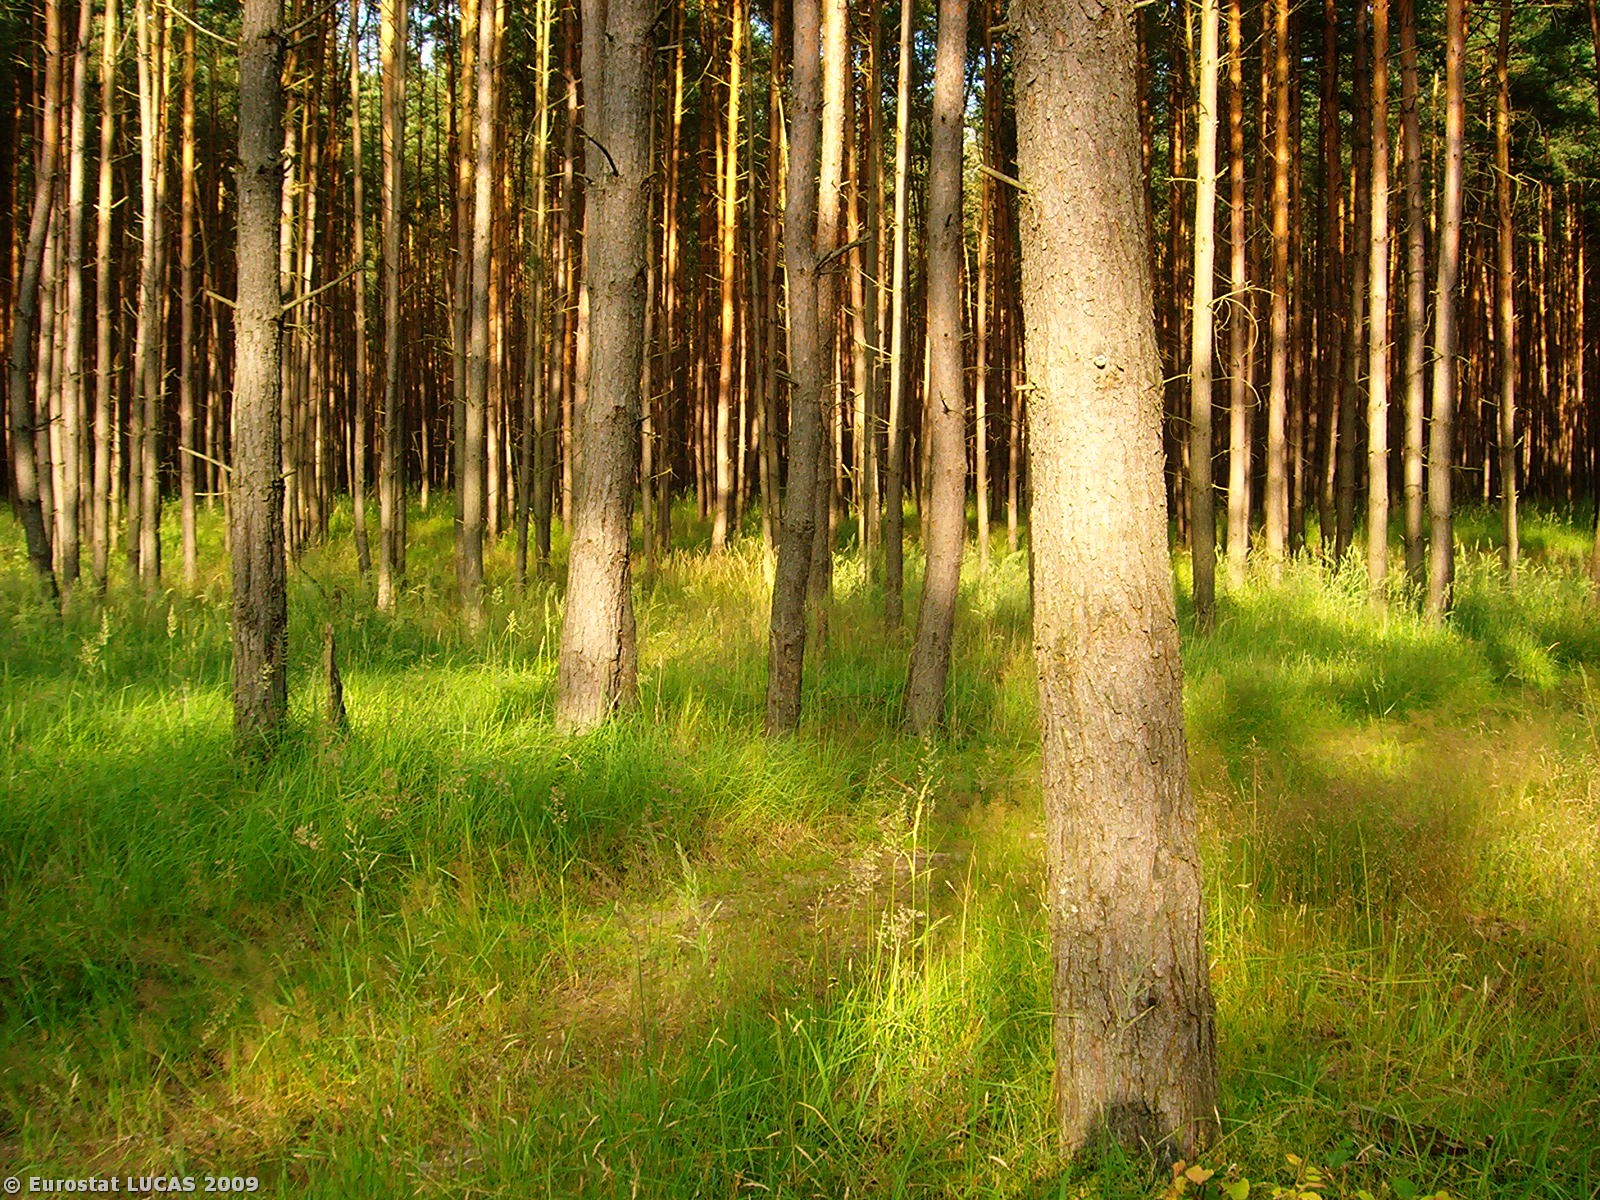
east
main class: Woodland
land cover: Coniferous woodland
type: hemiboreal forest and nemoral coniferous forest and mixed broadleaved-coniferous forest
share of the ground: 50 - 75 %
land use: Forestry
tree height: > 5 m
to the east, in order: Coniferous woodland; Tracks; Coniferous woodland
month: July
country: PL
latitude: 52.2992
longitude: 15.2089
